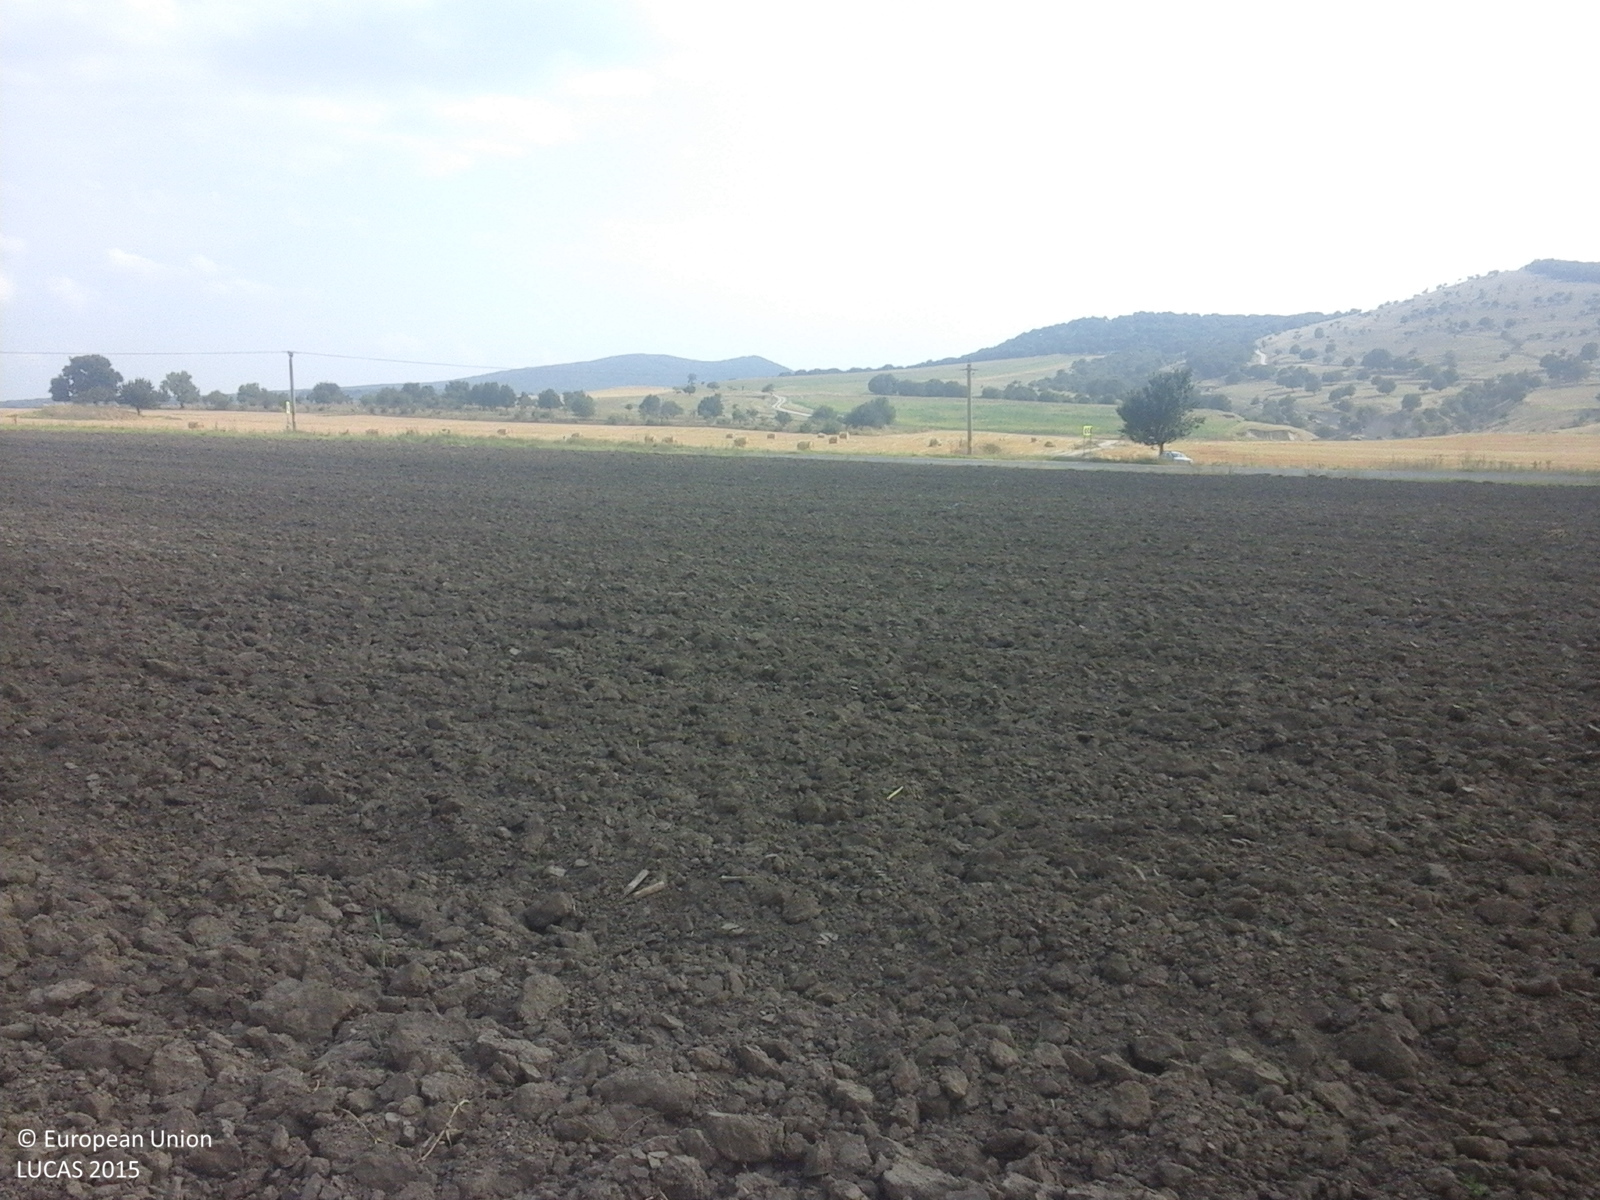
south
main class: Cropland
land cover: Common wheat
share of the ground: < 10 %
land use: Agriculture (excluding fallow land and kitchen gardens)
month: July
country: RO
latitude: 45.0164
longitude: 28.3854
